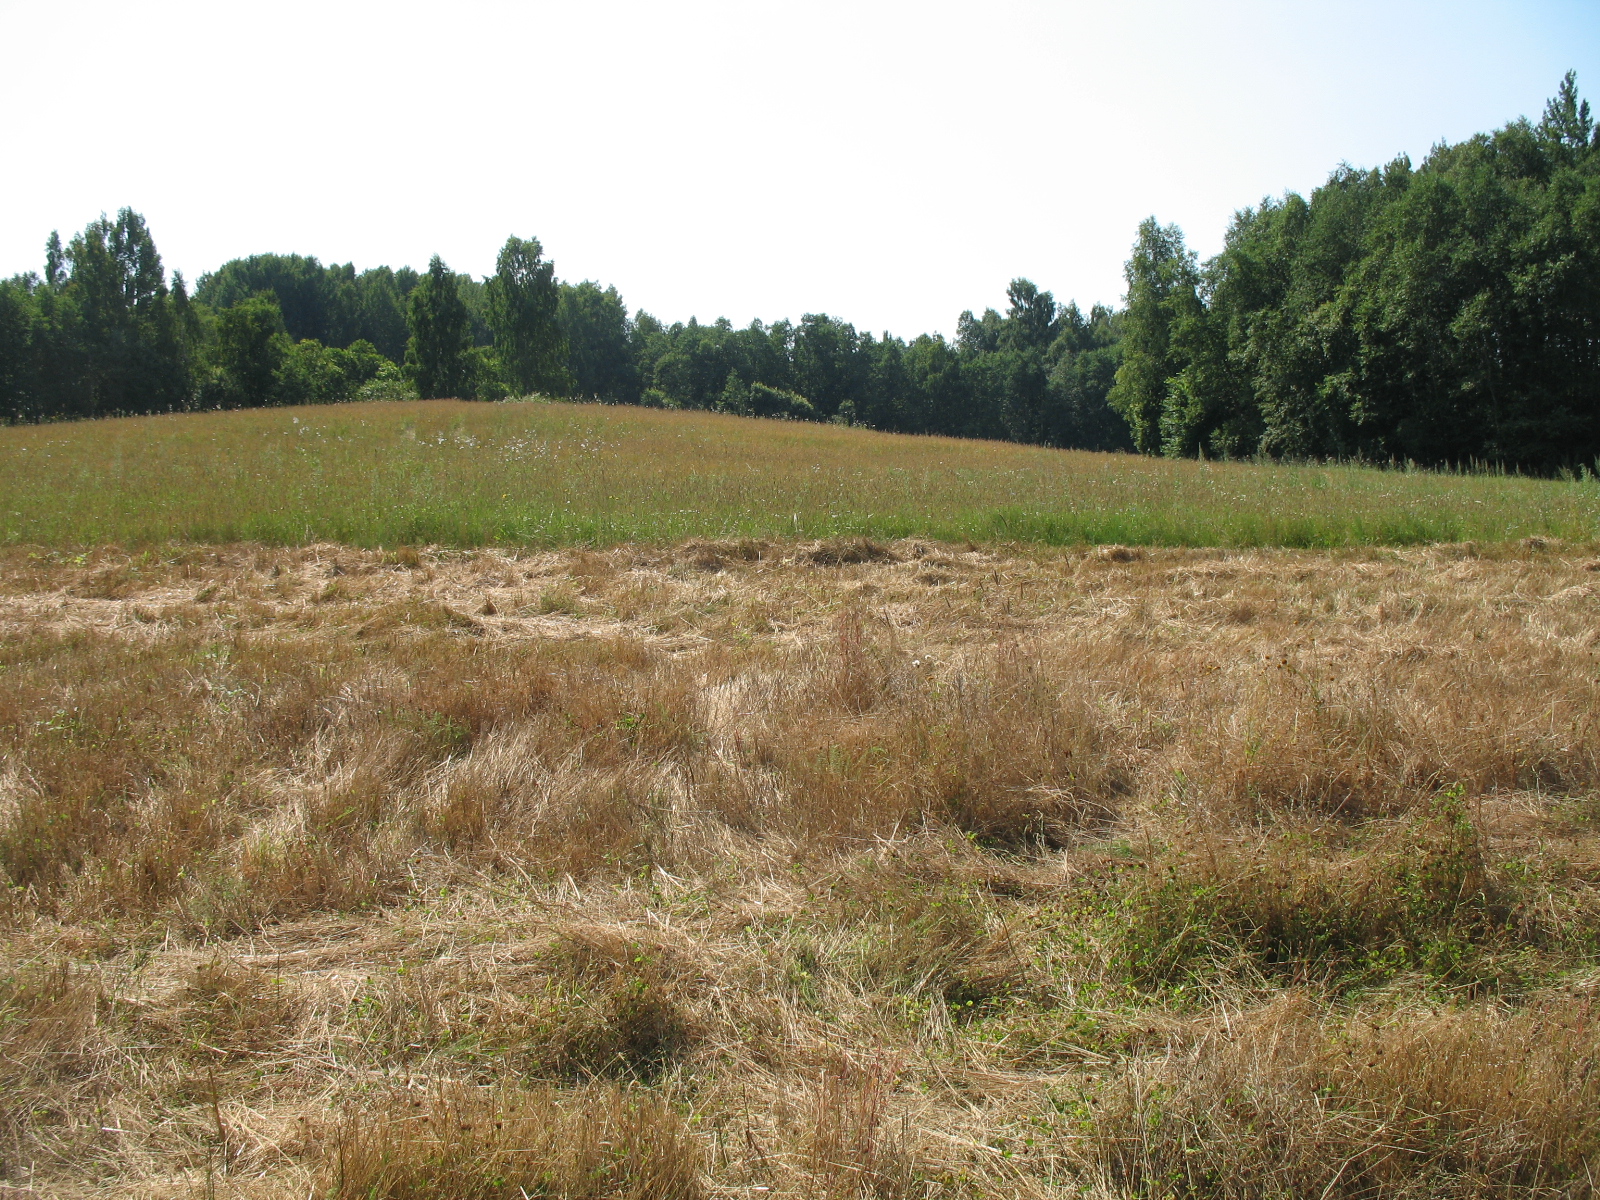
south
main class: Grassland
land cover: Grassland without tree/shrub cover
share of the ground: > 75 %
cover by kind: herbaceous plants 100 %
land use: Agriculture (excluding fallow land and kitchen gardens)
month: August
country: LV
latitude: 56.2096
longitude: 25.3532
